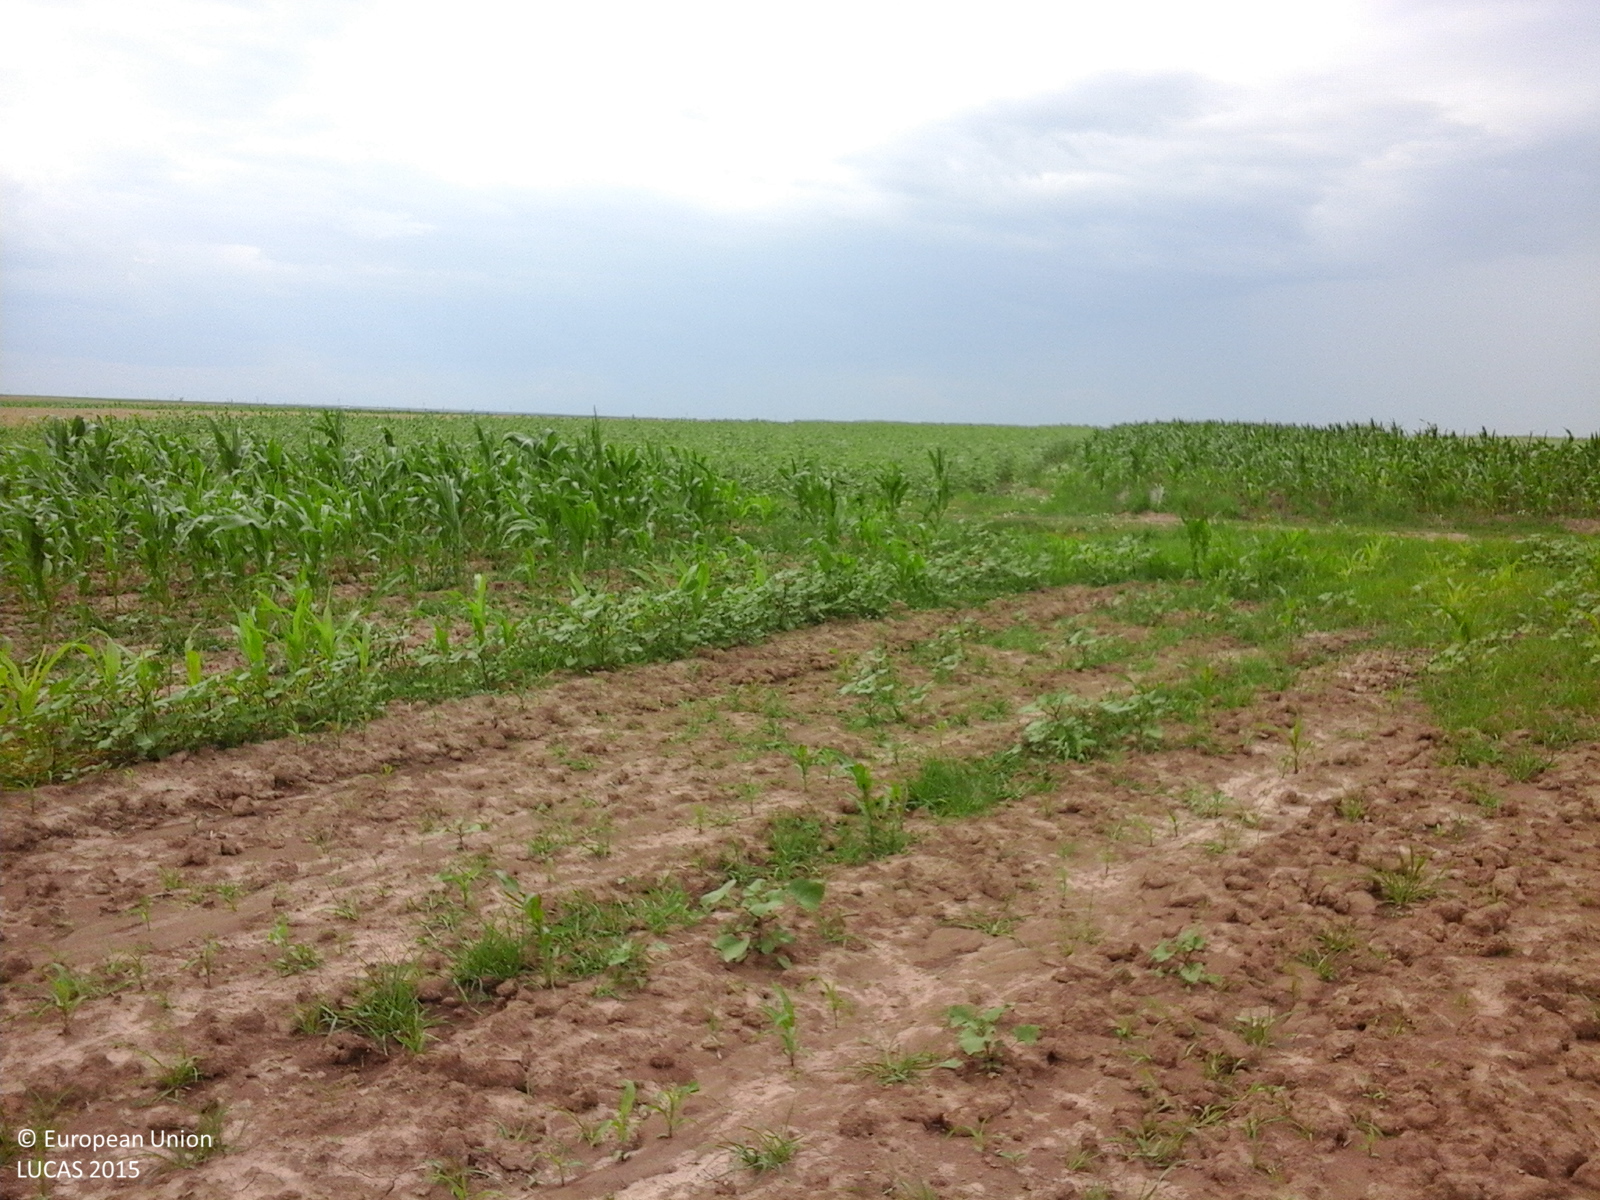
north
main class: Grassland
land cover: Spontaneously vegetated surfaces
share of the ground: 25 - 50 %
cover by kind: herbaceous plants 100 %
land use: Agriculture (excluding fallow land and kitchen gardens)
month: July
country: RO
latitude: 44.4740
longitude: 25.4142
